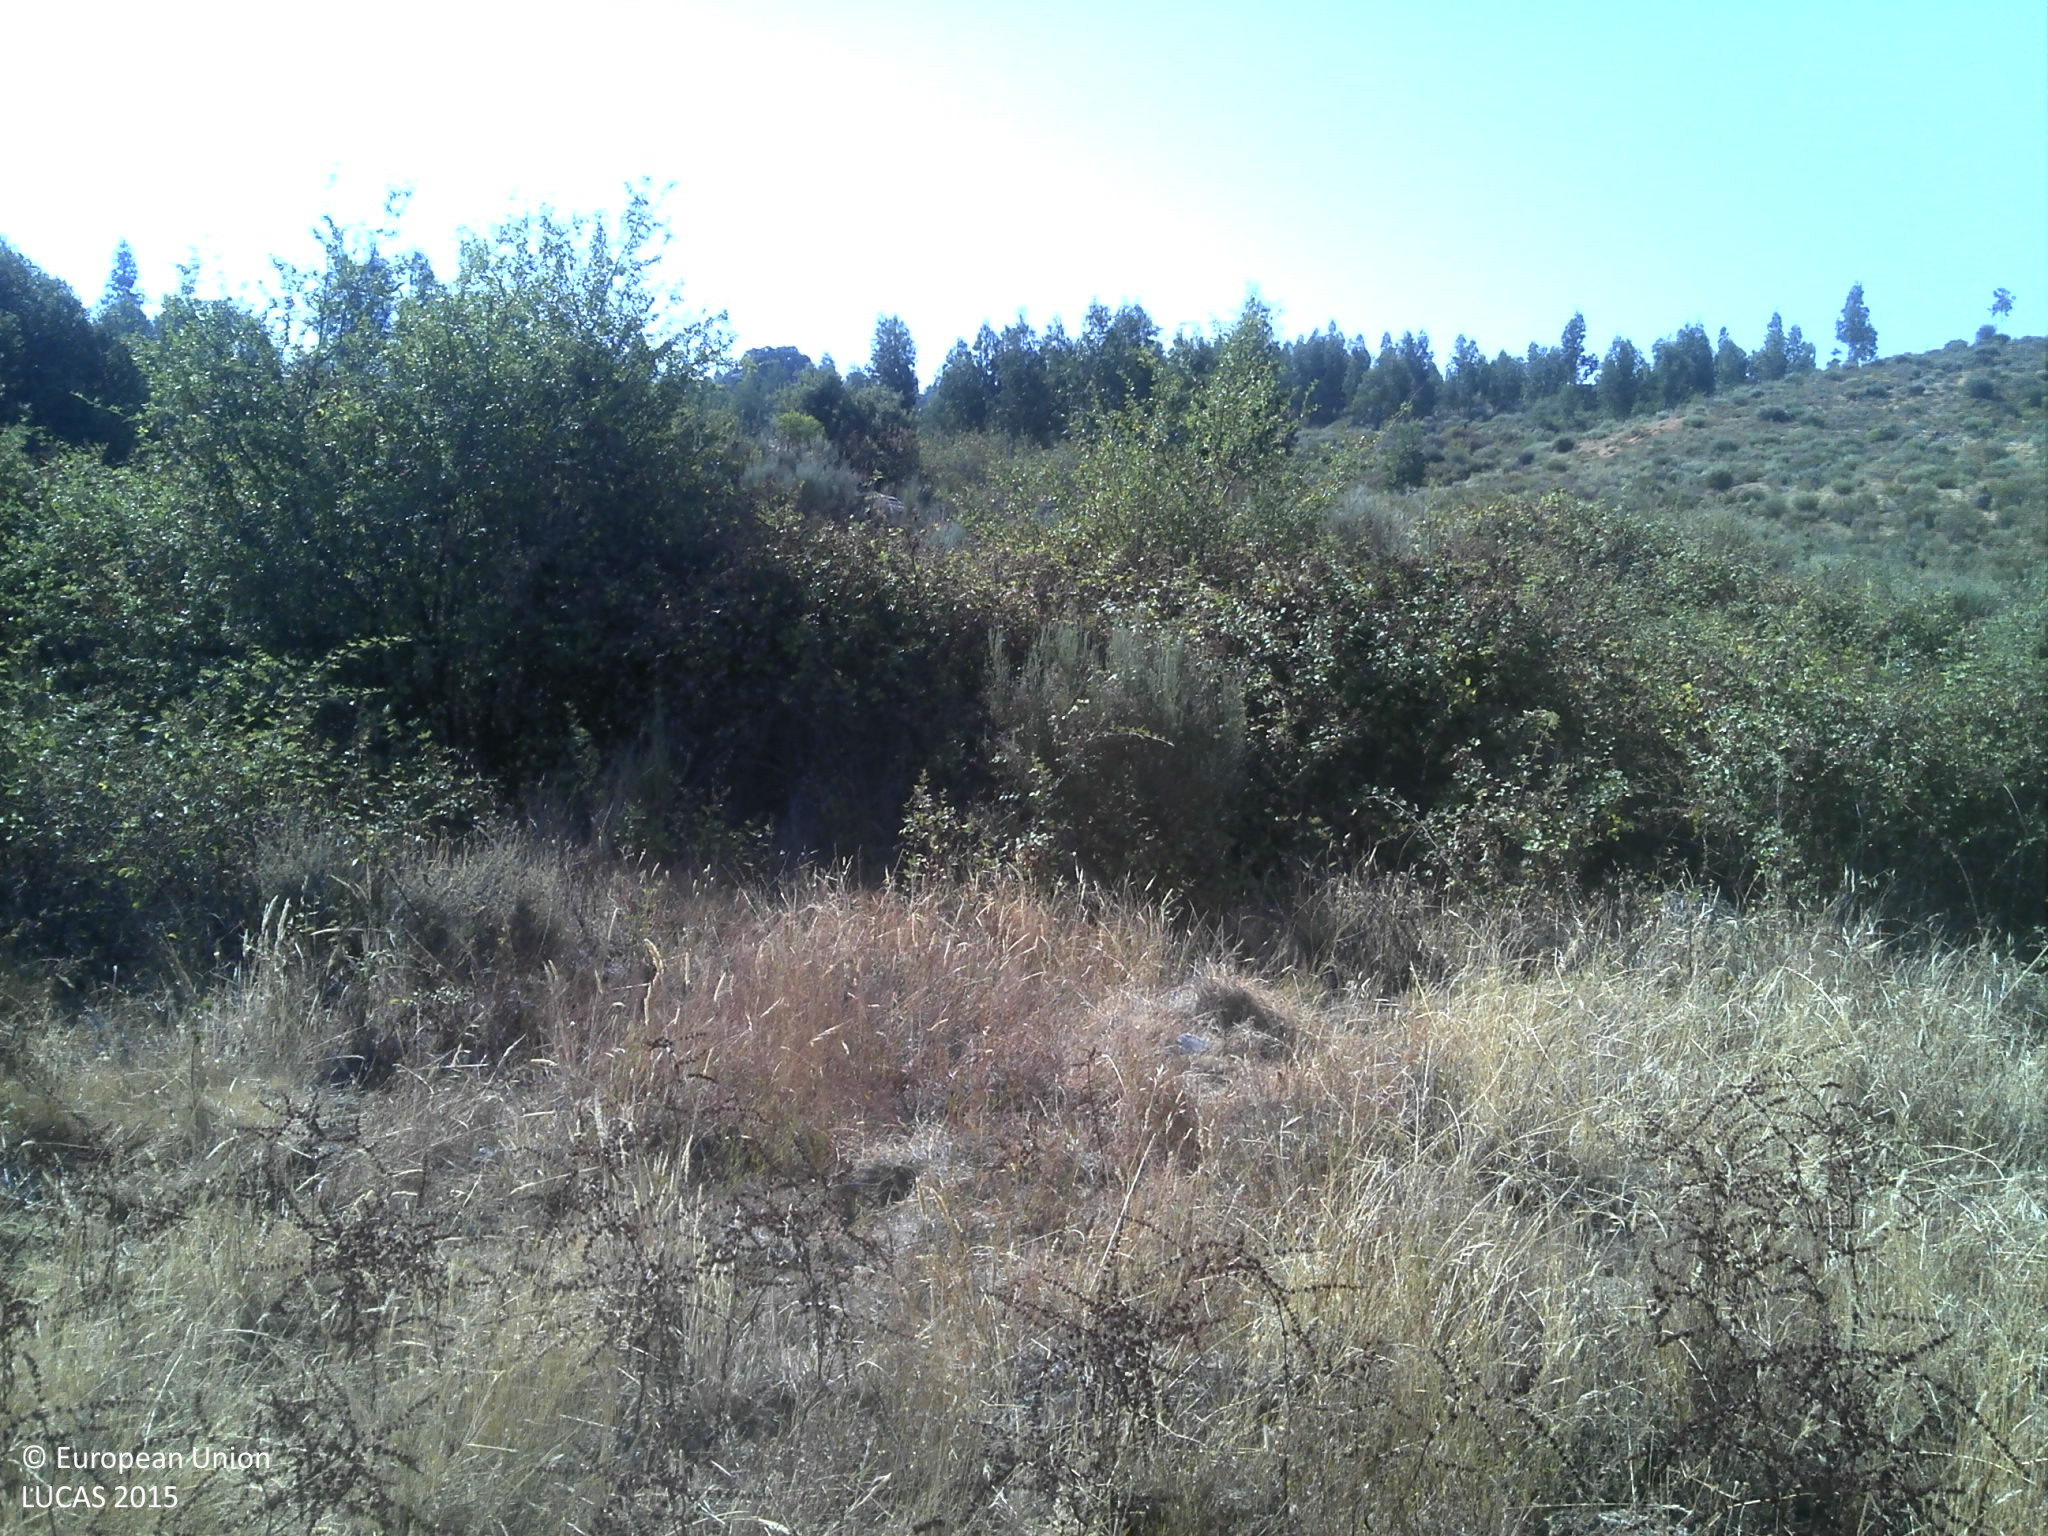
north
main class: Grassland
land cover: Grassland without tree/shrub cover
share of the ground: 50 - 75 %
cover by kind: herbaceous plants 65 %, unconsolidated bare surface 35 %
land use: Agriculture (excluding fallow land and kitchen gardens)
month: July
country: PT
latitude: 39.9953
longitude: -7.3751
